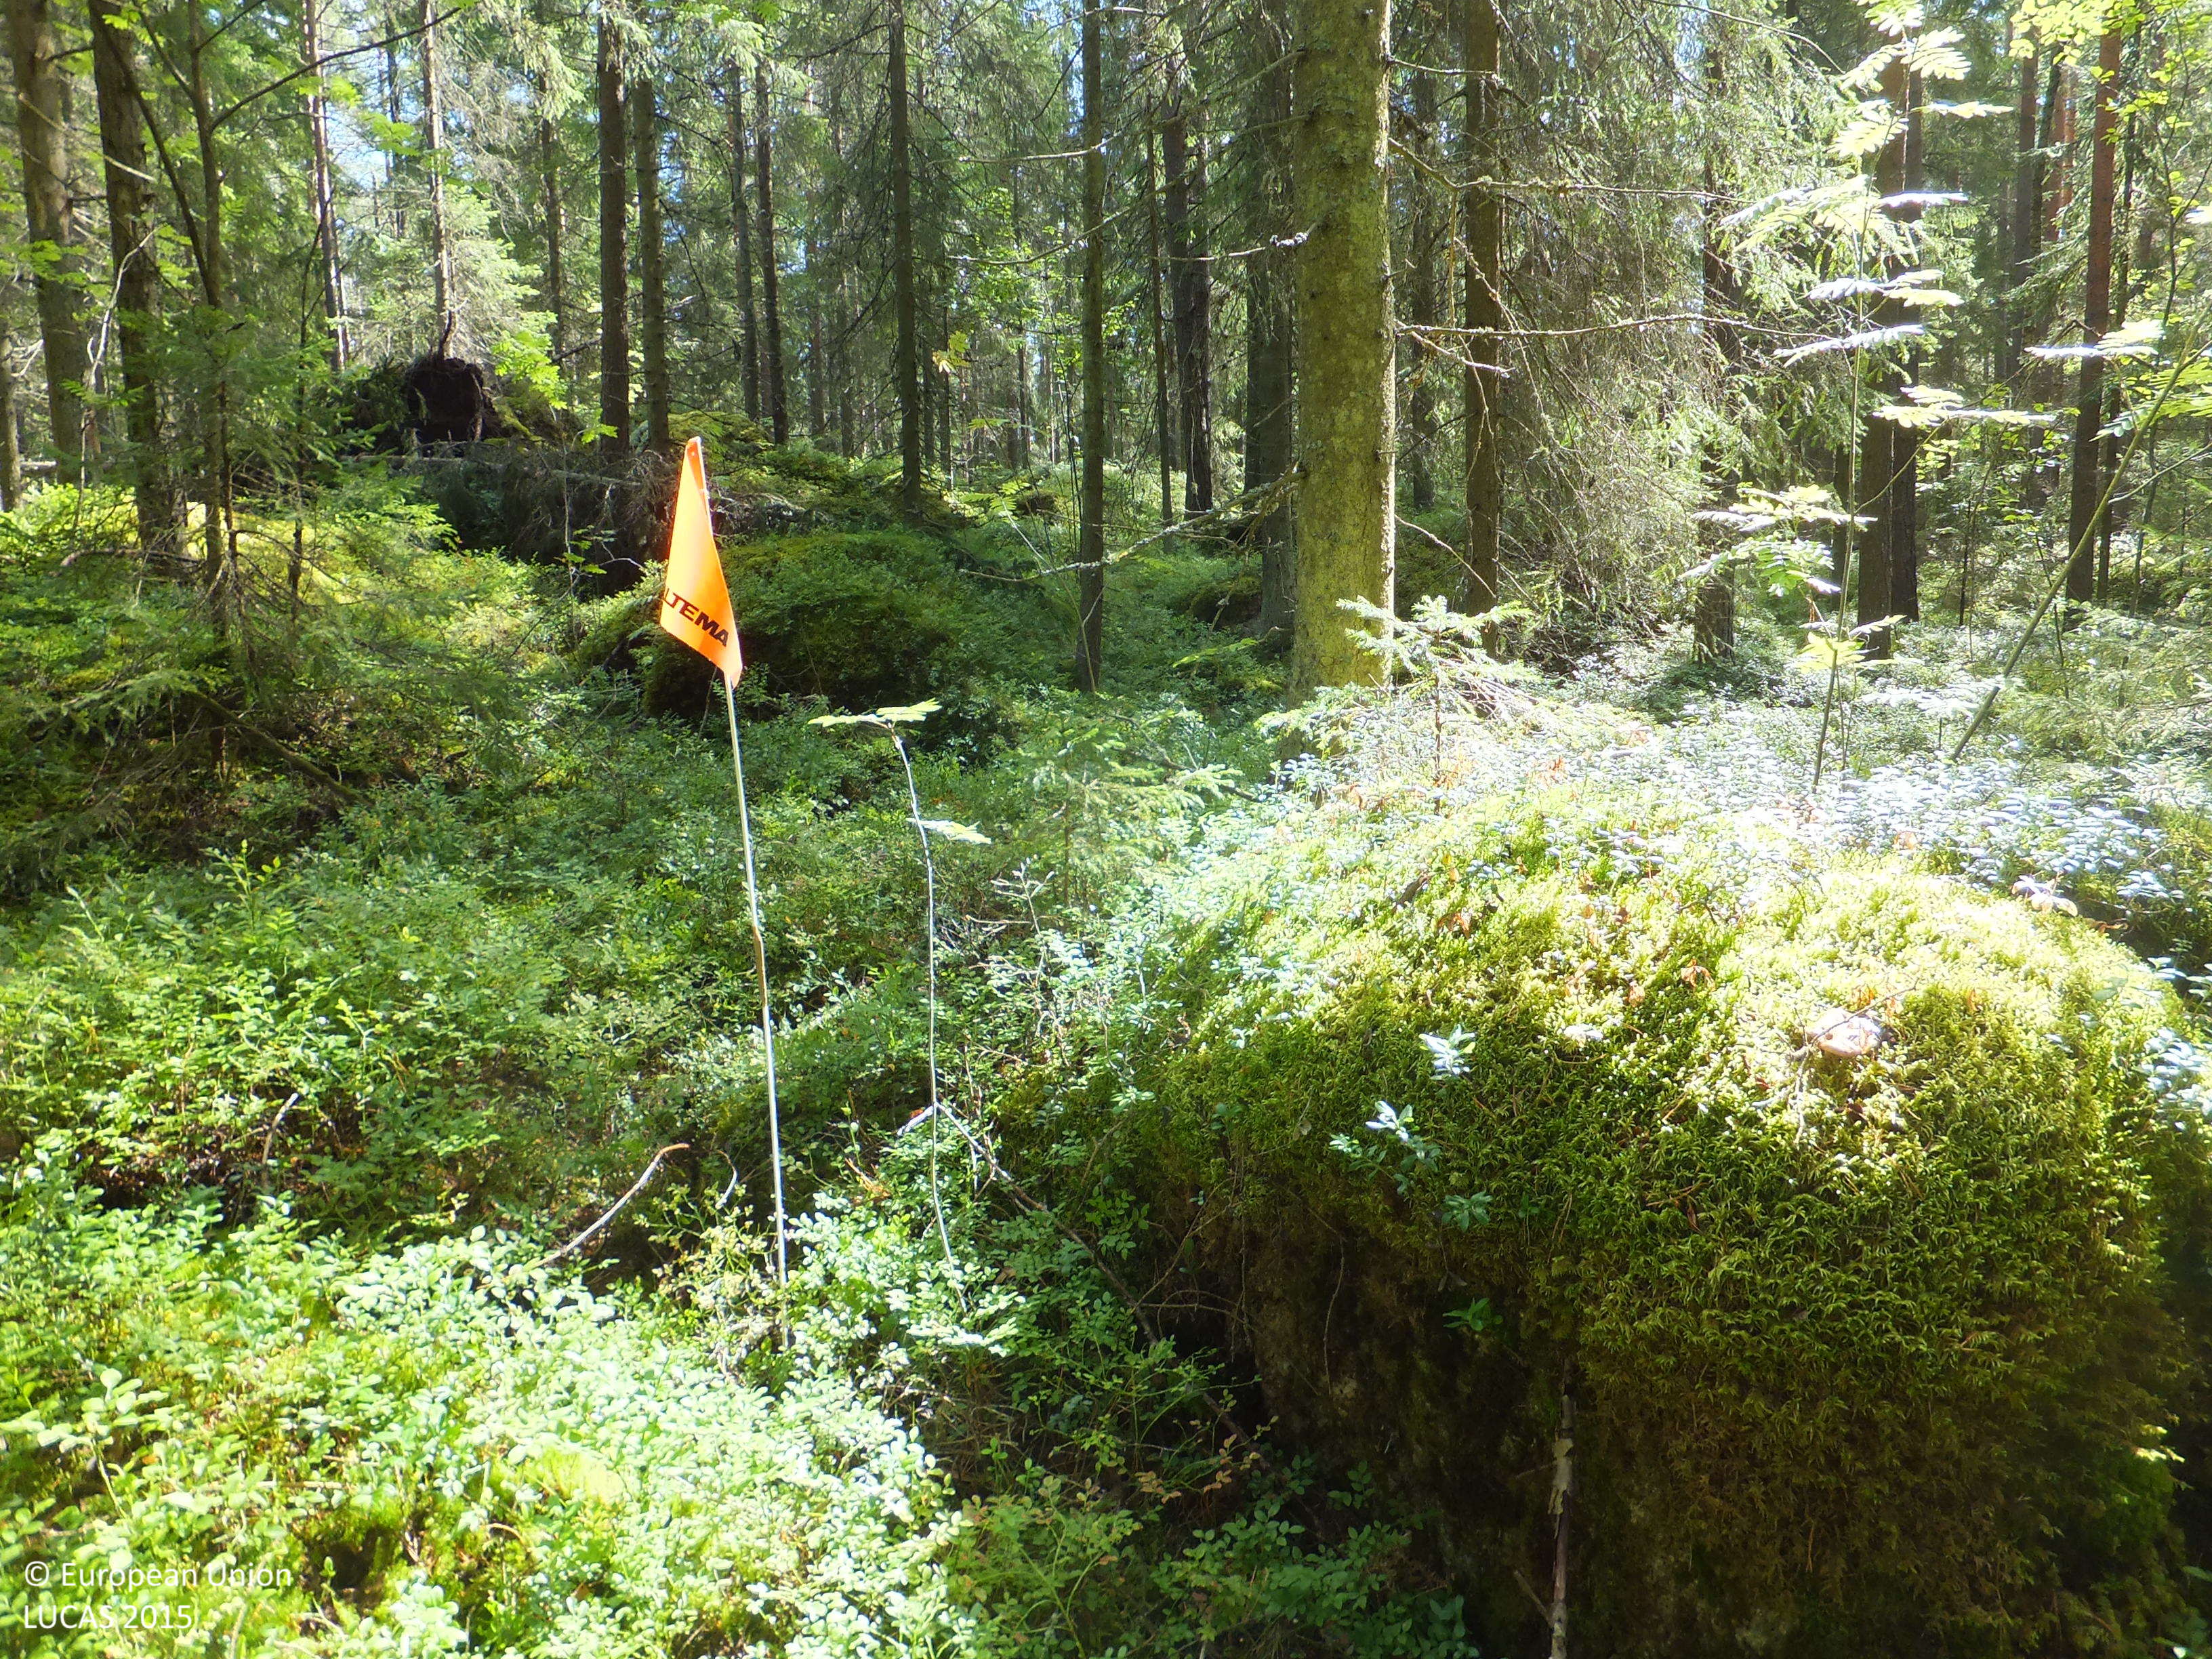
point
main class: Woodland
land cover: Other coniferous woodland
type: boreal forest
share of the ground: > 75 %
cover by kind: coniferous forest trees 75 %, shrubs 10 %, lichens and mosses 10 %, broadleaved forest trees 5 %
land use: Forestry
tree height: > 5 m
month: August
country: FI
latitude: 63.2292
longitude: 23.0924
